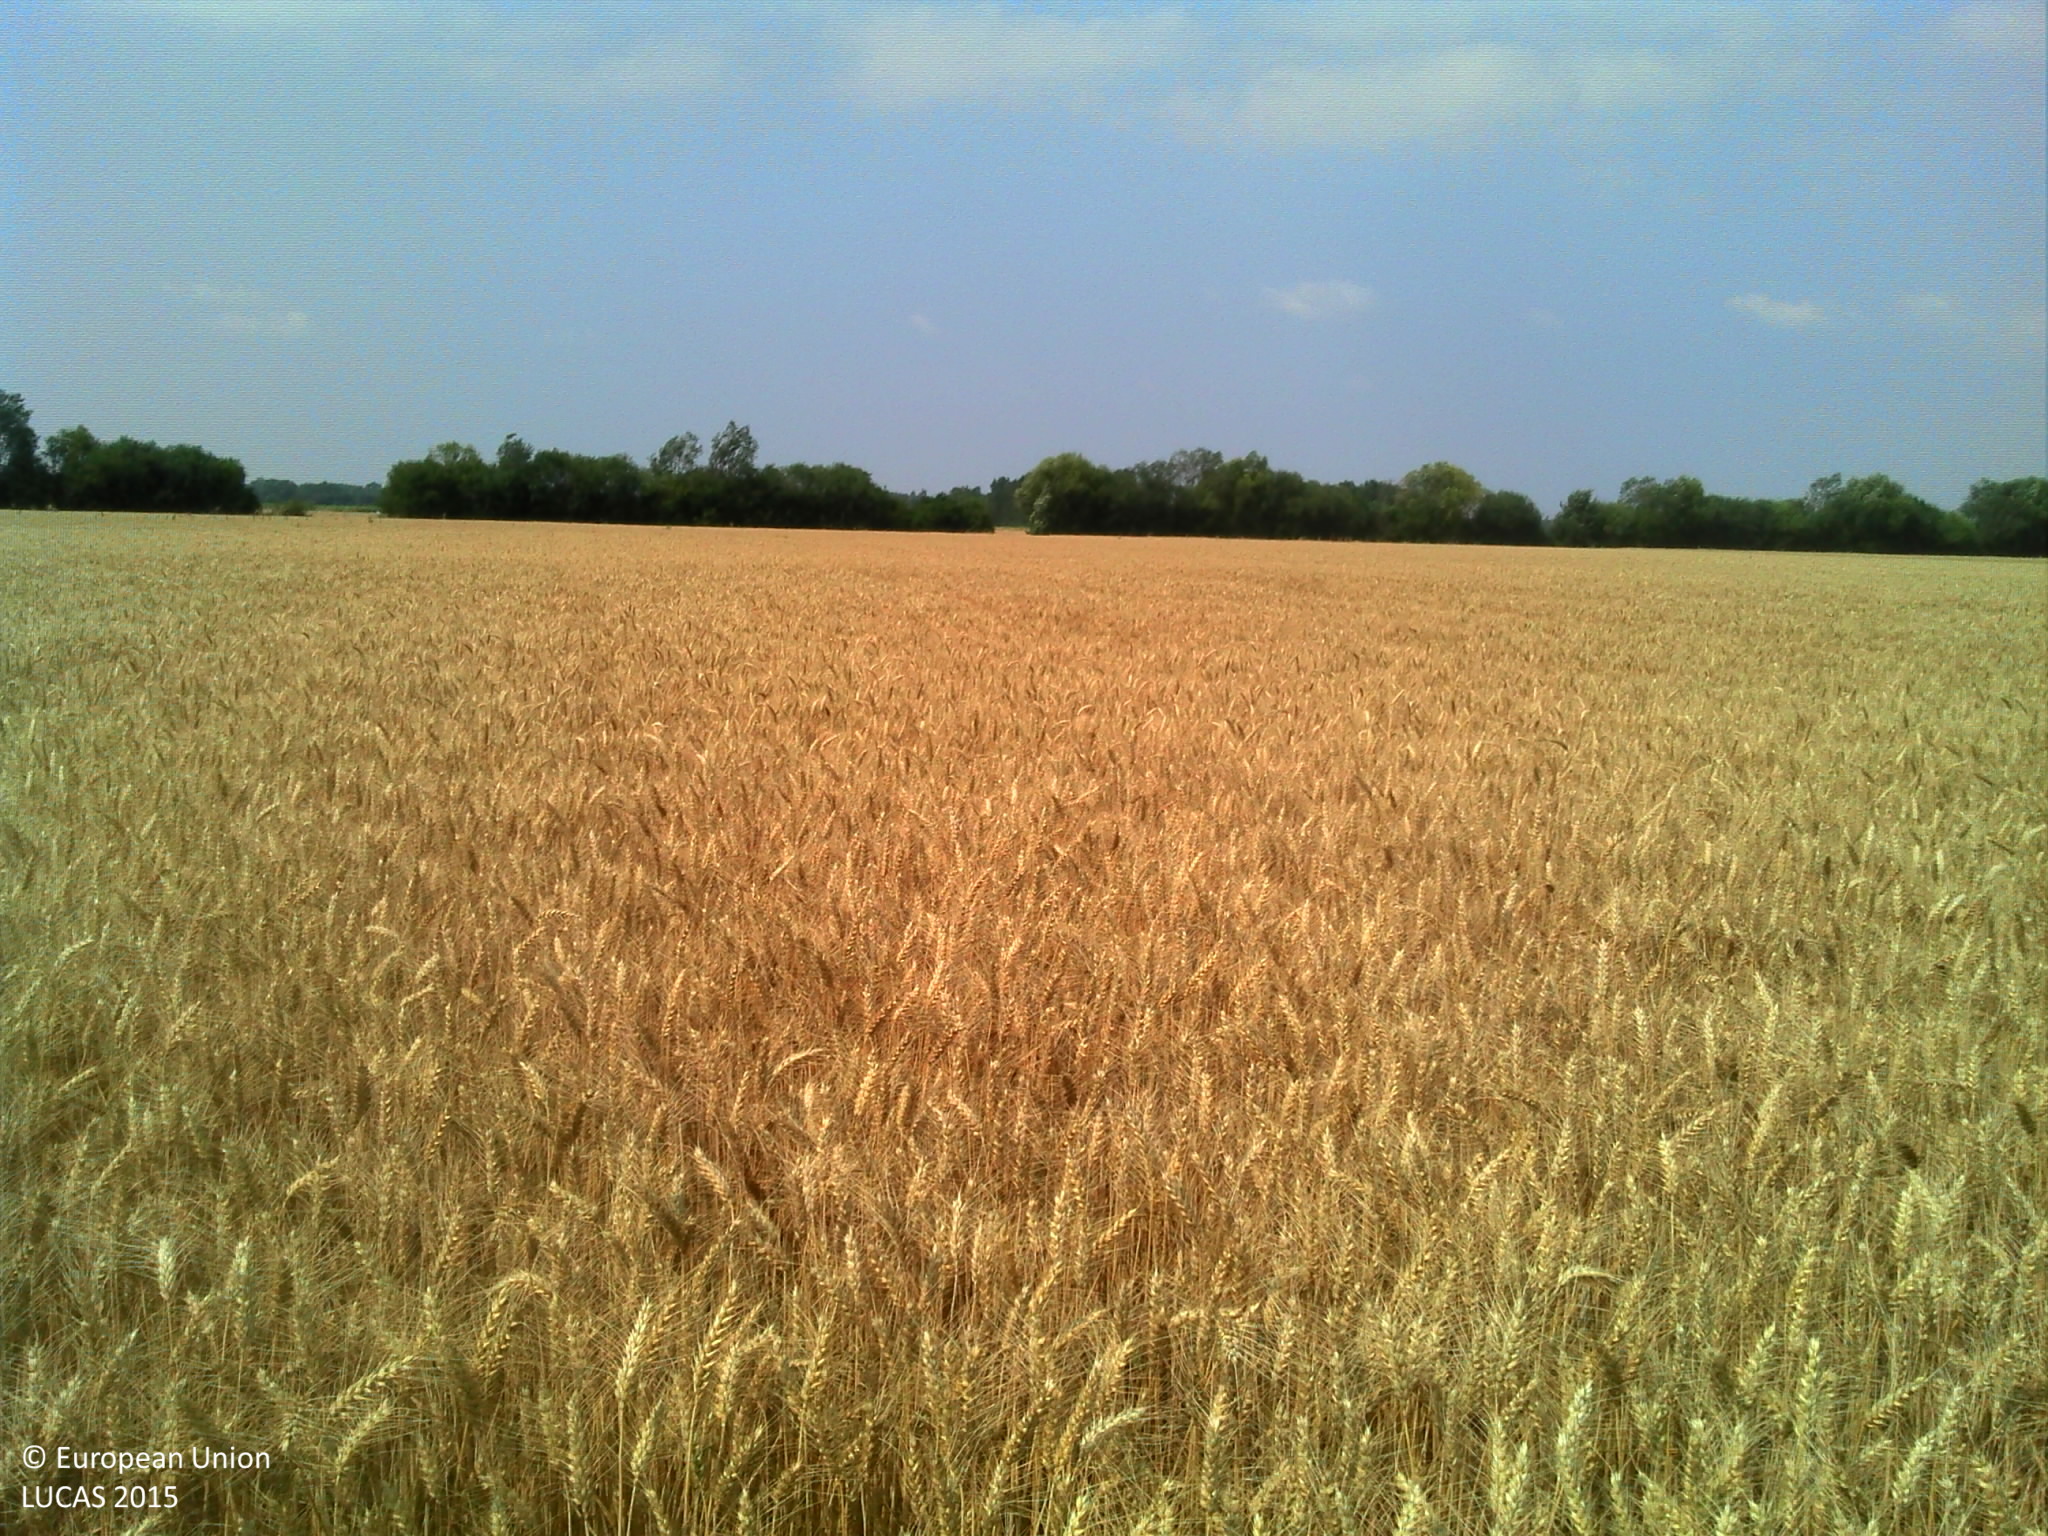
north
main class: Cropland
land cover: Durum wheat
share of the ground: > 75 %
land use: Agriculture (excluding fallow land and kitchen gardens)
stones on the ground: < 10 %
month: July
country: FR
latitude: 47.2184
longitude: 0.1388
